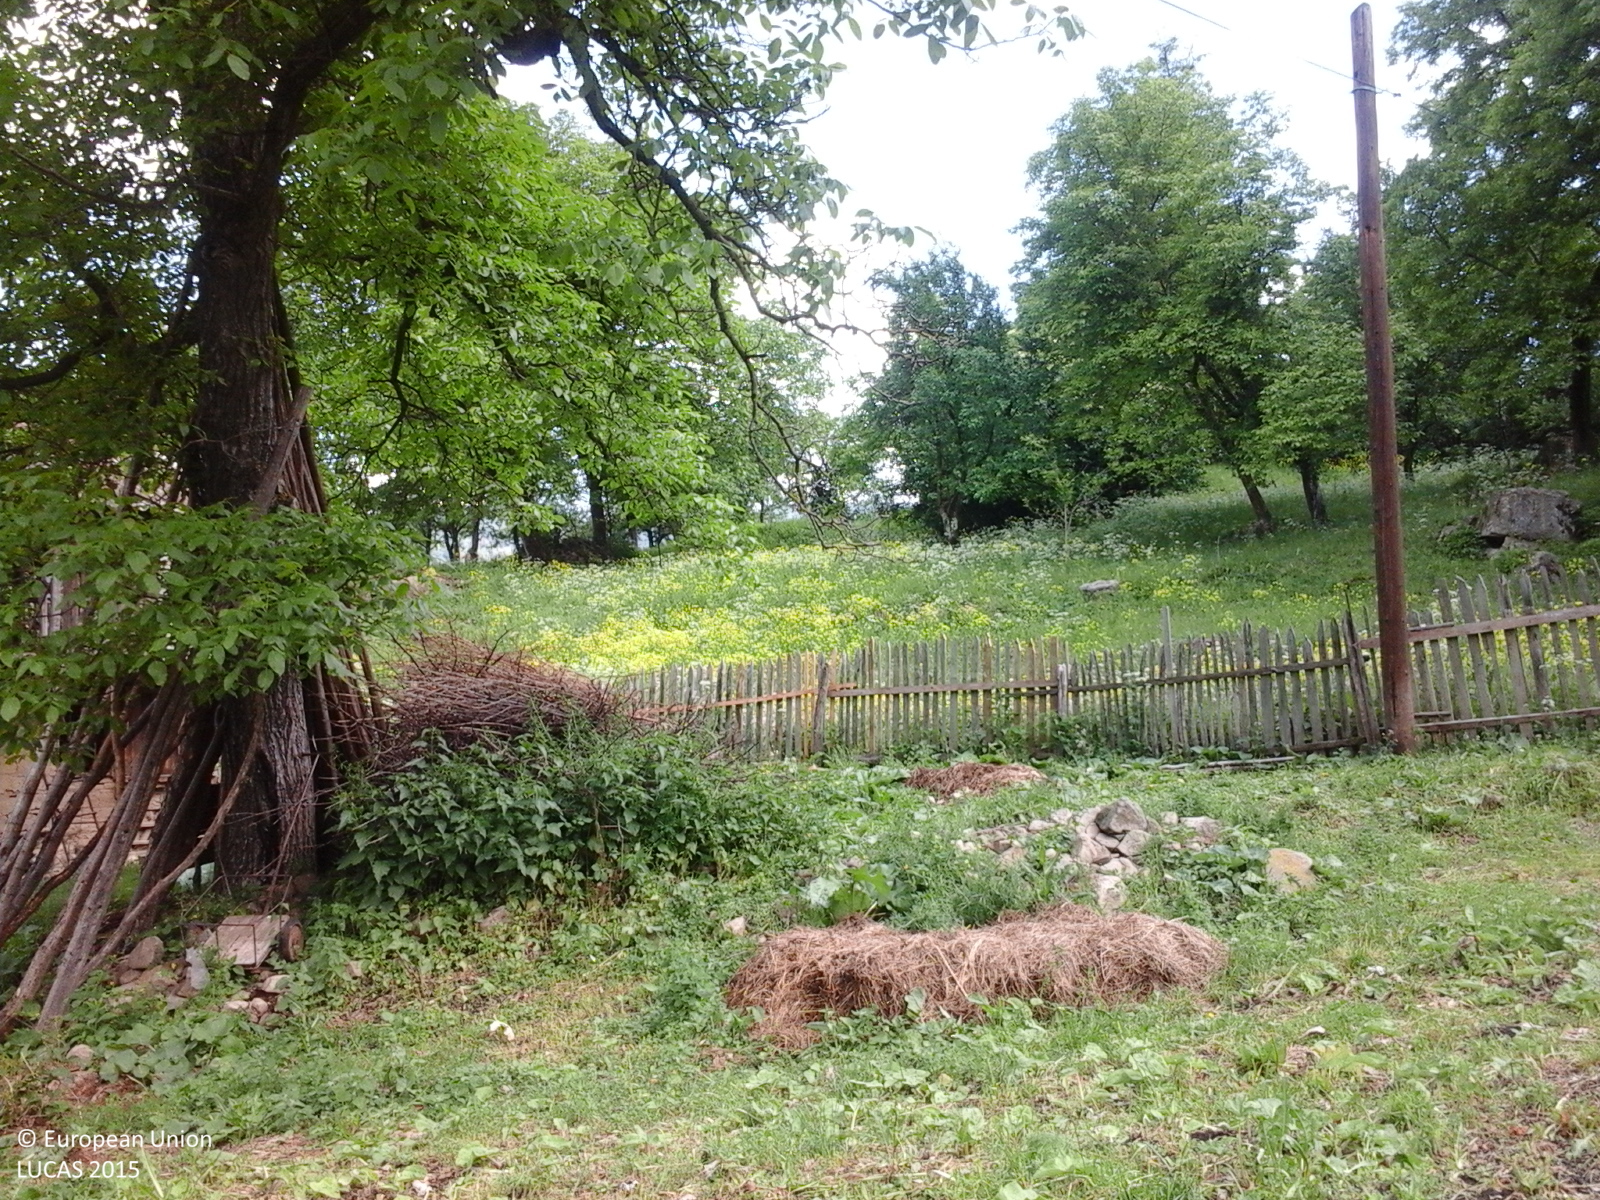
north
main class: Grassland
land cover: Grassland without tree/shrub cover
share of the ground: > 75 %
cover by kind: herbaceous plants 100 %
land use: Agriculture (excluding fallow land and kitchen gardens)
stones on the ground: < 10 %
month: May
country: RO
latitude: 45.4364
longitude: 26.3166
